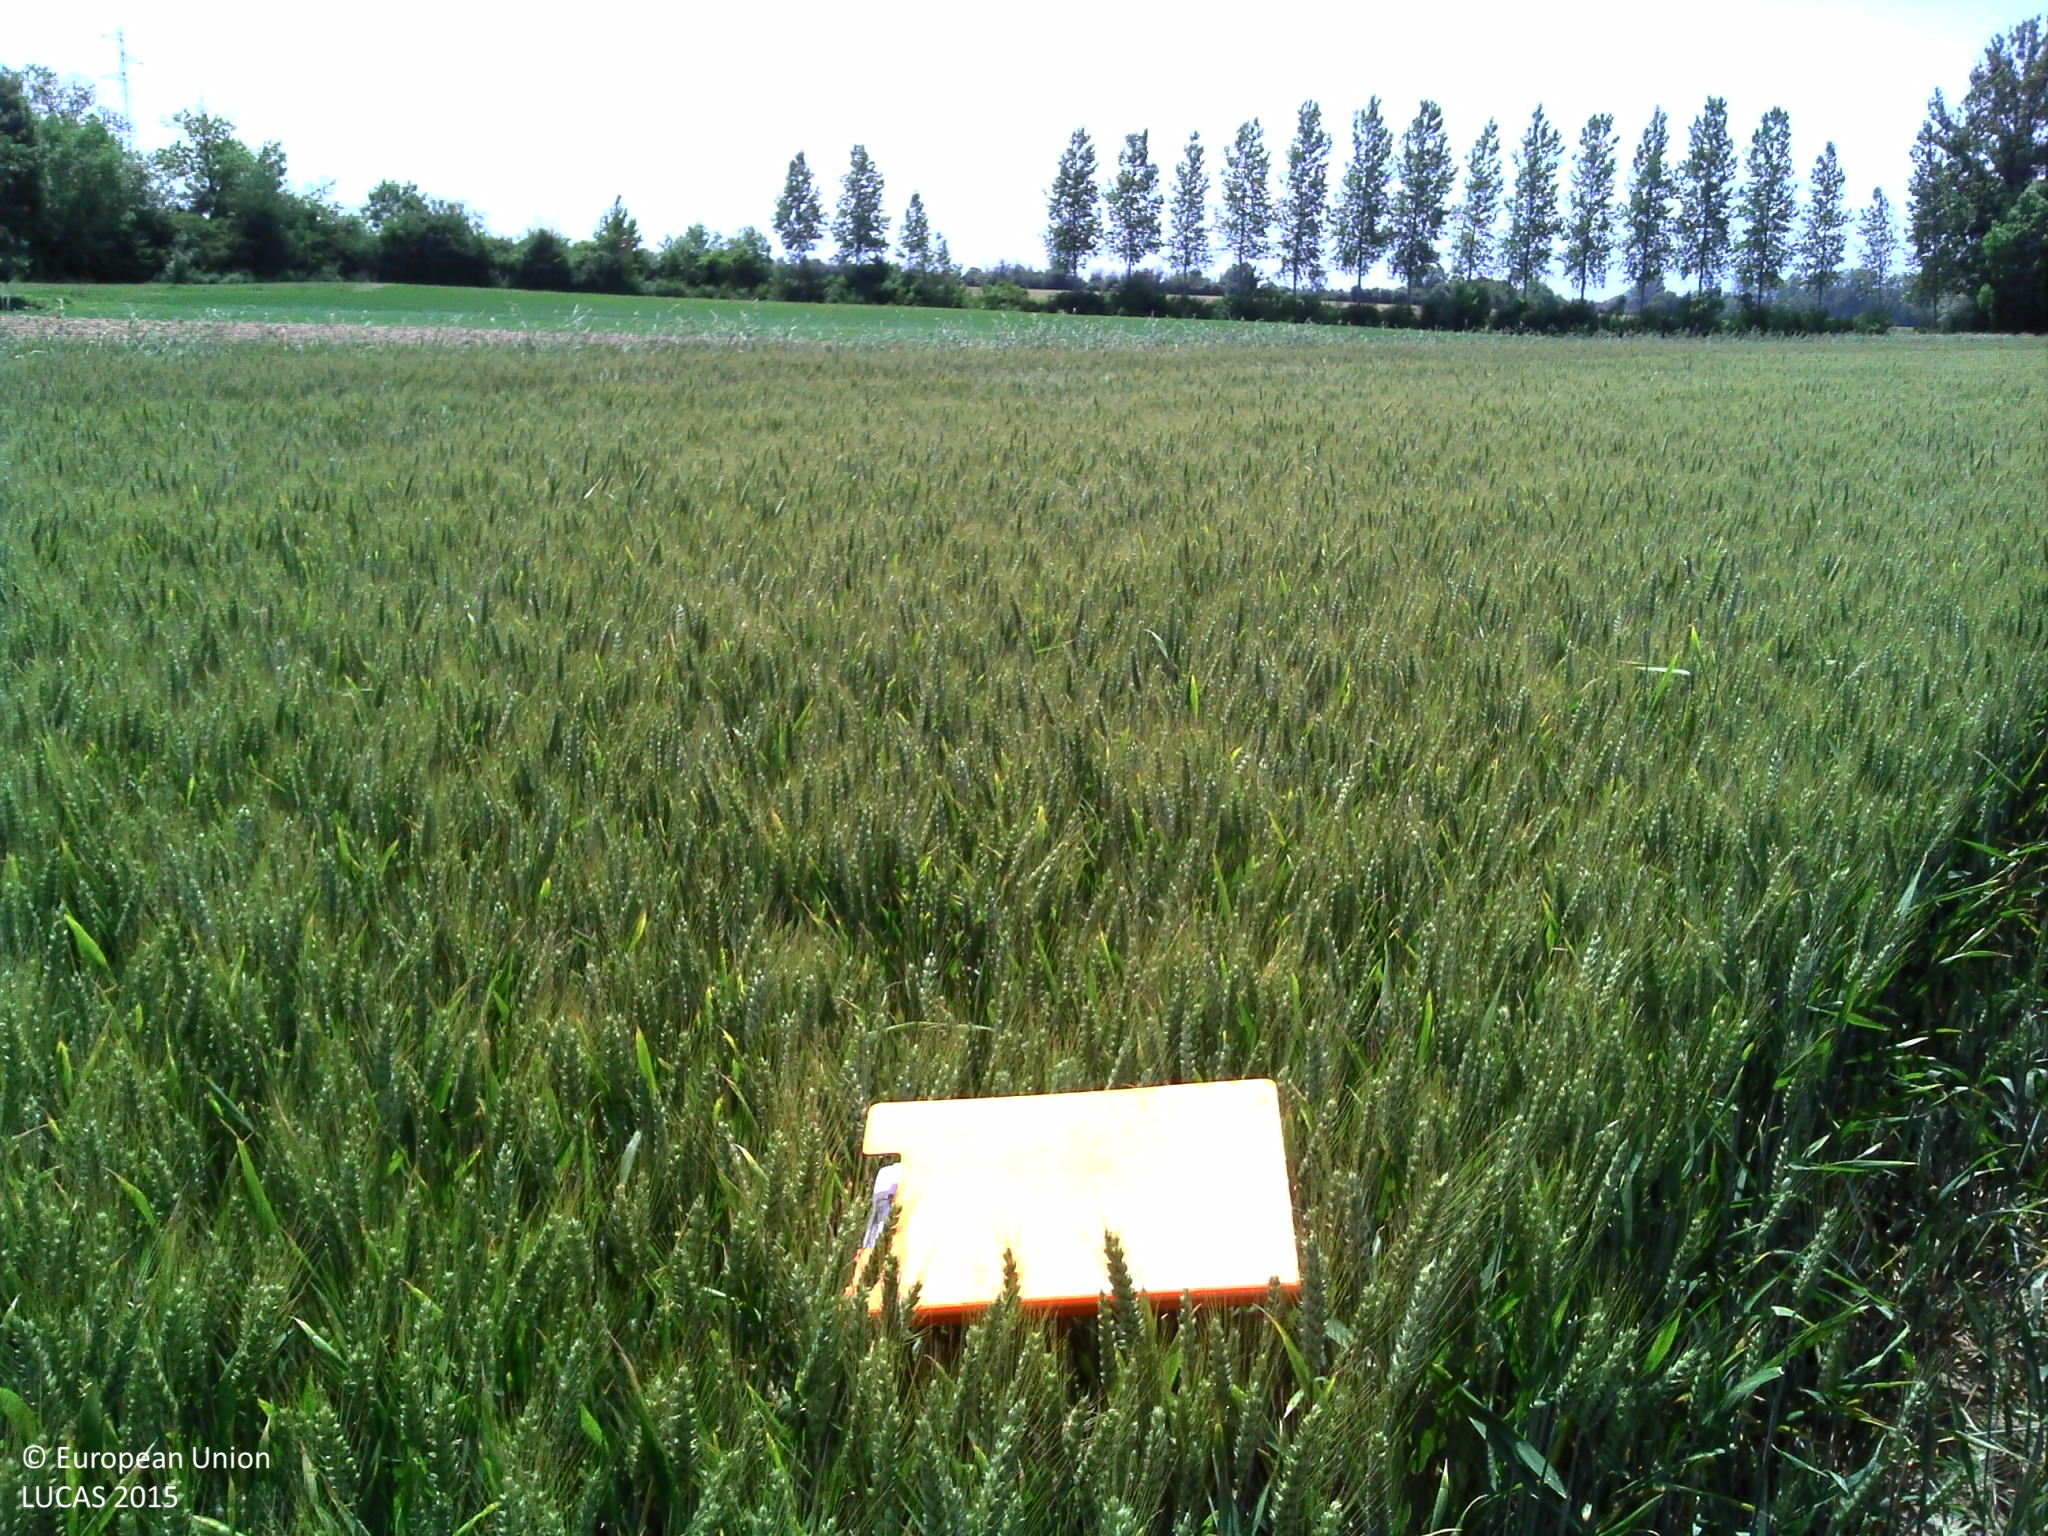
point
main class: Cropland
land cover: Common wheat
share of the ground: > 75 %
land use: Agriculture (excluding fallow land and kitchen gardens)
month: June
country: FR
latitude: 46.9497
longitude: 2.6761
